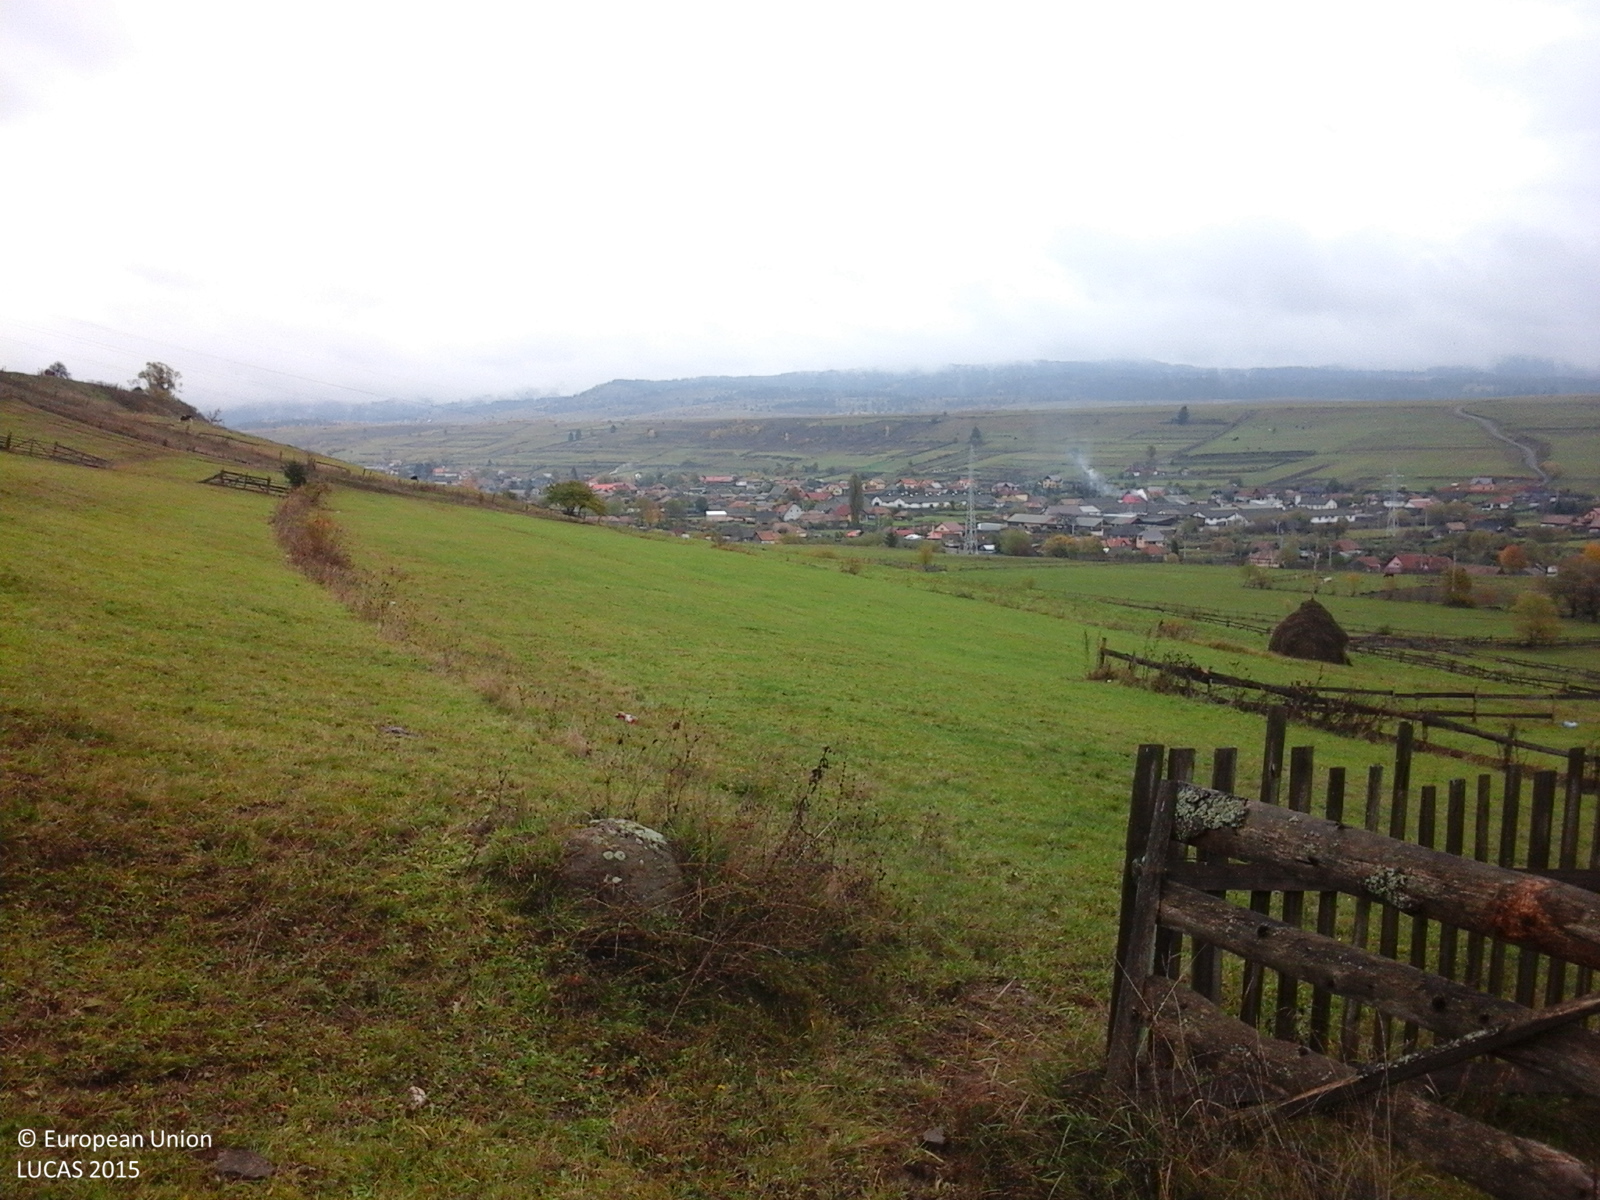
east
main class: Grassland
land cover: Grassland without tree/shrub cover
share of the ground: > 75 %
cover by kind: herbaceous plants 100 %
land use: Agriculture (excluding fallow land and kitchen gardens)
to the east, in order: Grassland without tree/shrub cover; Fences; Grassland without tree/shrub cover; Fences; Grassland without tree/shrub cover; Fences; Grassland without tree/shrub cover; Fences; Shruby margins; Grassland without tree/shrub cover; Fences; Grassland without tree/shrub cover; Fences; Grass margins; Tracks; Grass margins; Fences; Grassland without tree/shrub cover; Fences; Grassland without tree/shrub cover
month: October
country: RO
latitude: 46.9373
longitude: 25.3594
